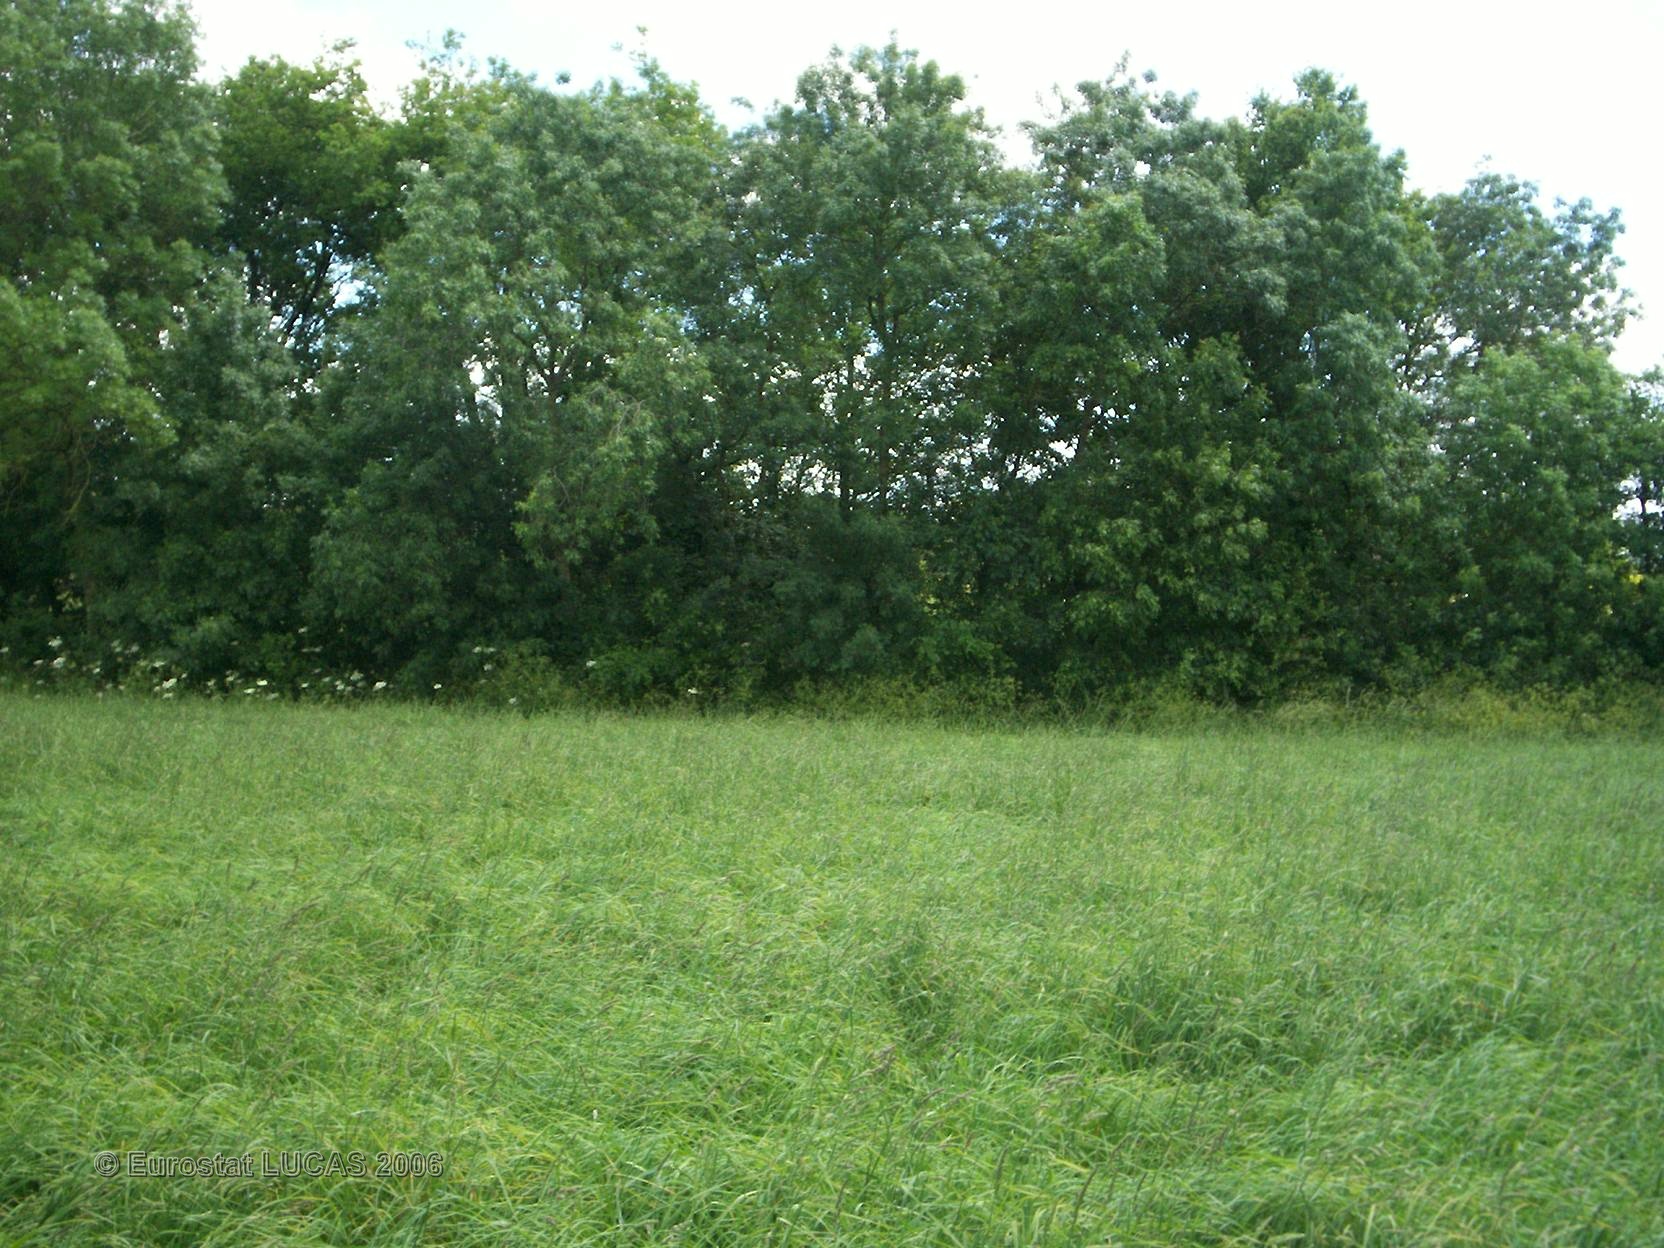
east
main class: Grassland
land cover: Grassland without tree/shrub cover
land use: Agriculture (excluding fallow land and kitchen gardens)
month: May
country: FR
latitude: 47.4421
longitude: -1.1103
